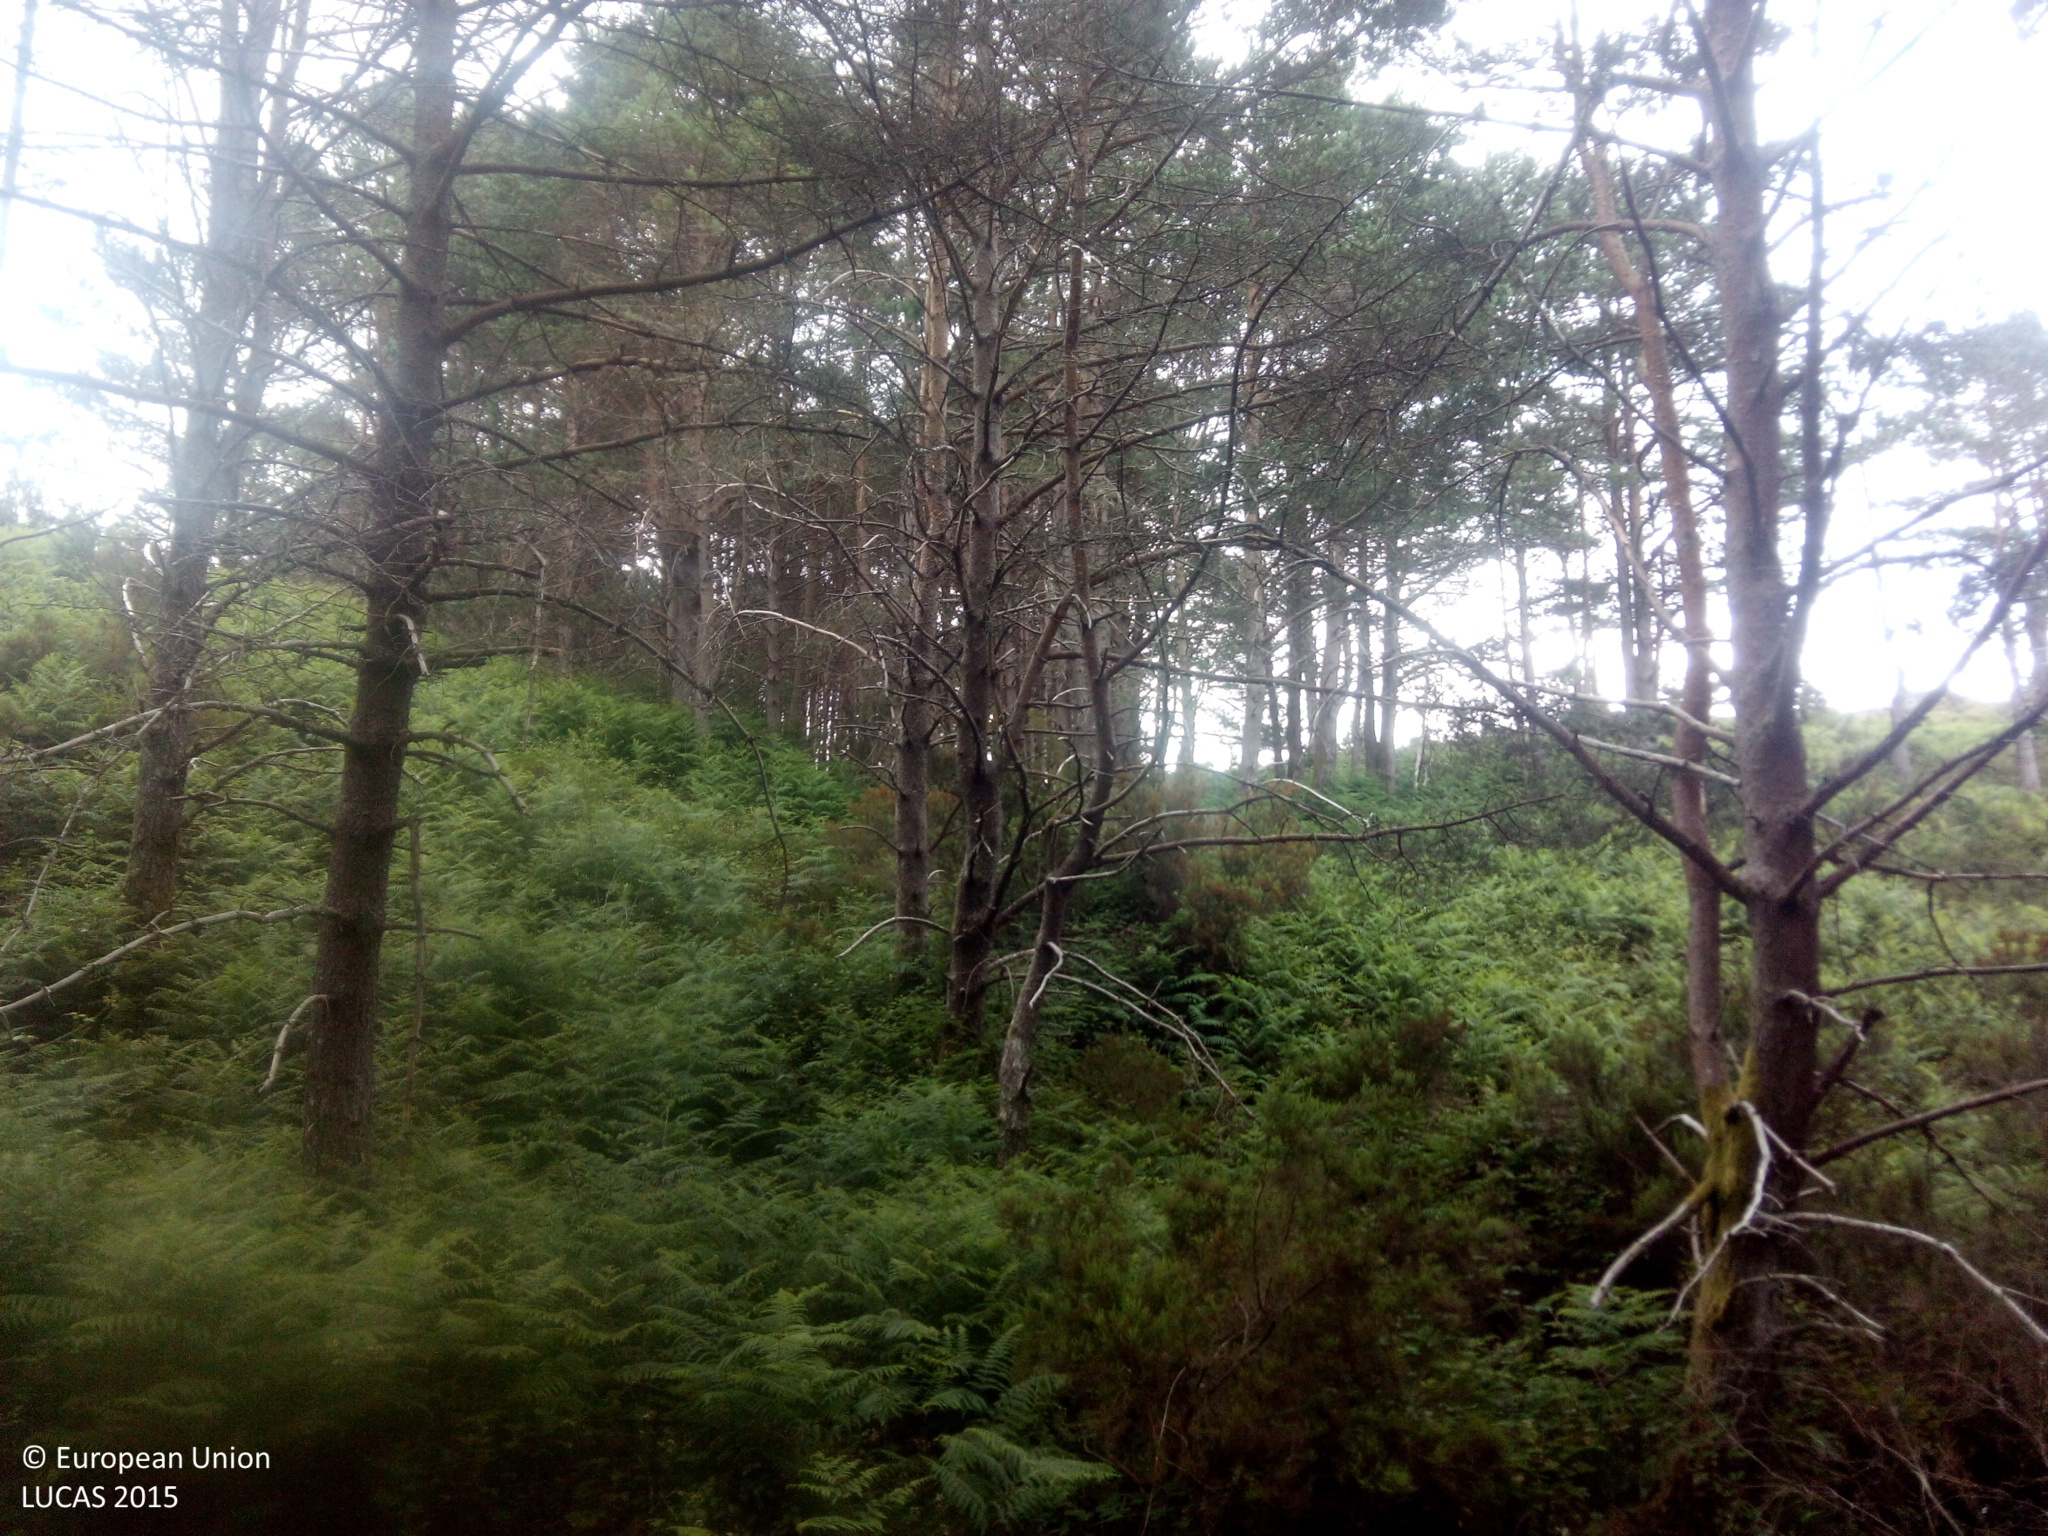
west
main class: Woodland
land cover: Pine dominated coniferous woodland
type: exotic forest
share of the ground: > 75 %
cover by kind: coniferous forest trees 100 %
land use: Forestry
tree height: > 5 m
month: July
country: ES
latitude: 42.3091
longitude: -8.2490
